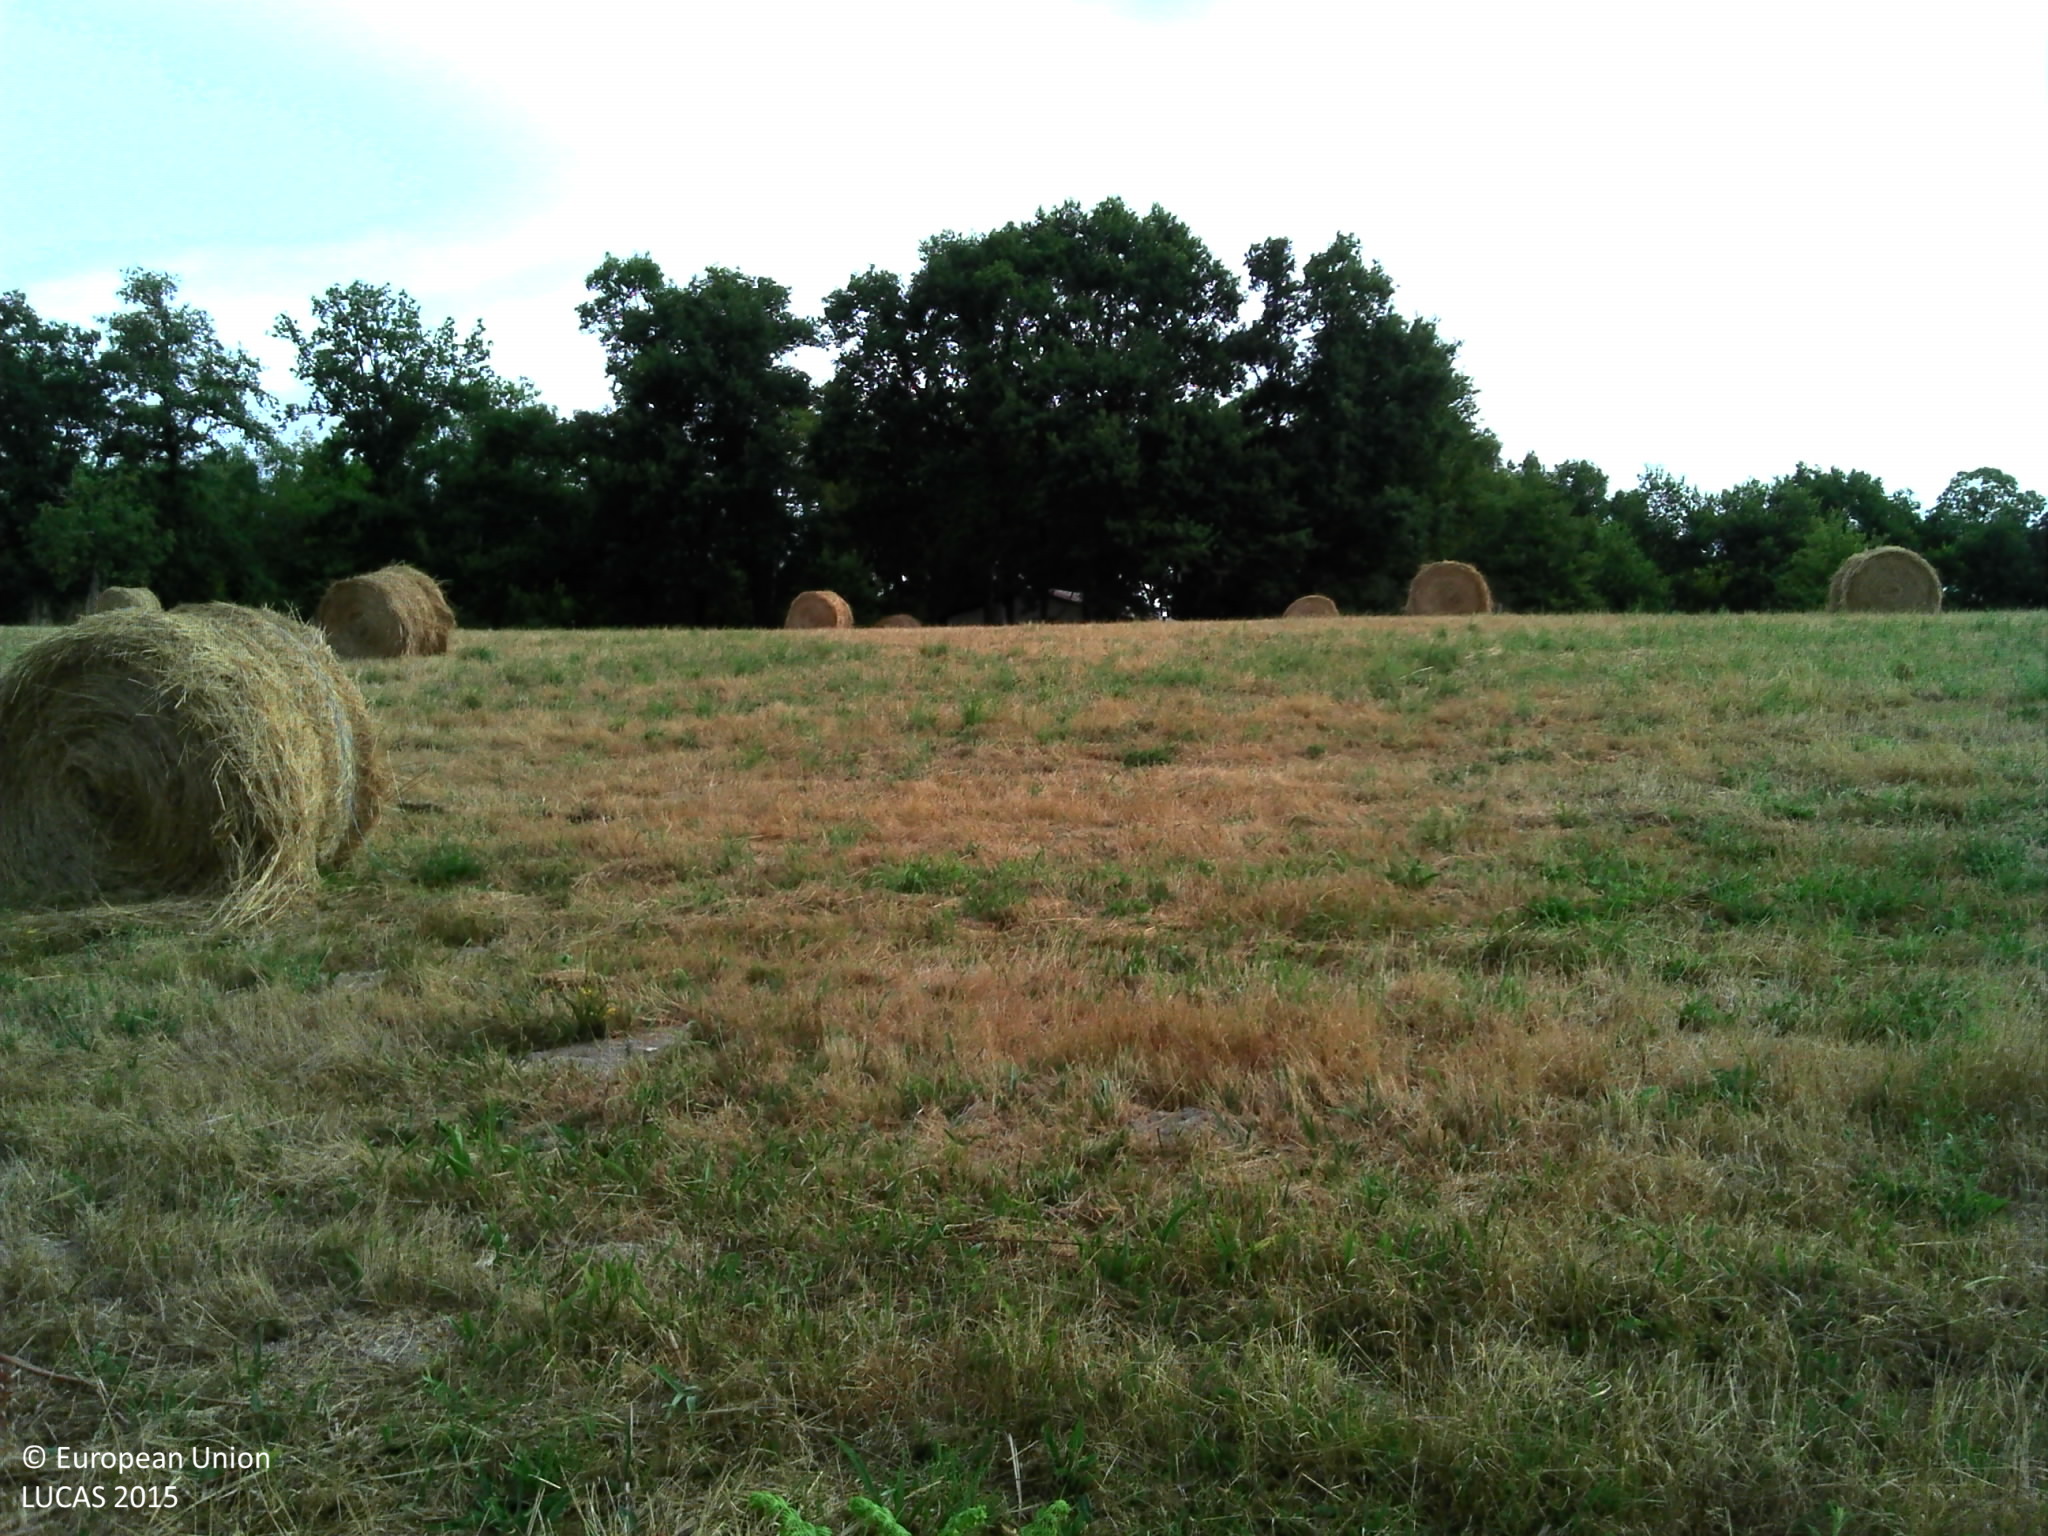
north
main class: Grassland
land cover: Grassland without tree/shrub cover
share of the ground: > 75 %
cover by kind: herbaceous plants 95 %
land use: Agriculture (excluding fallow land and kitchen gardens)
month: July
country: FR
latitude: 45.8455
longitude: 1.0141
